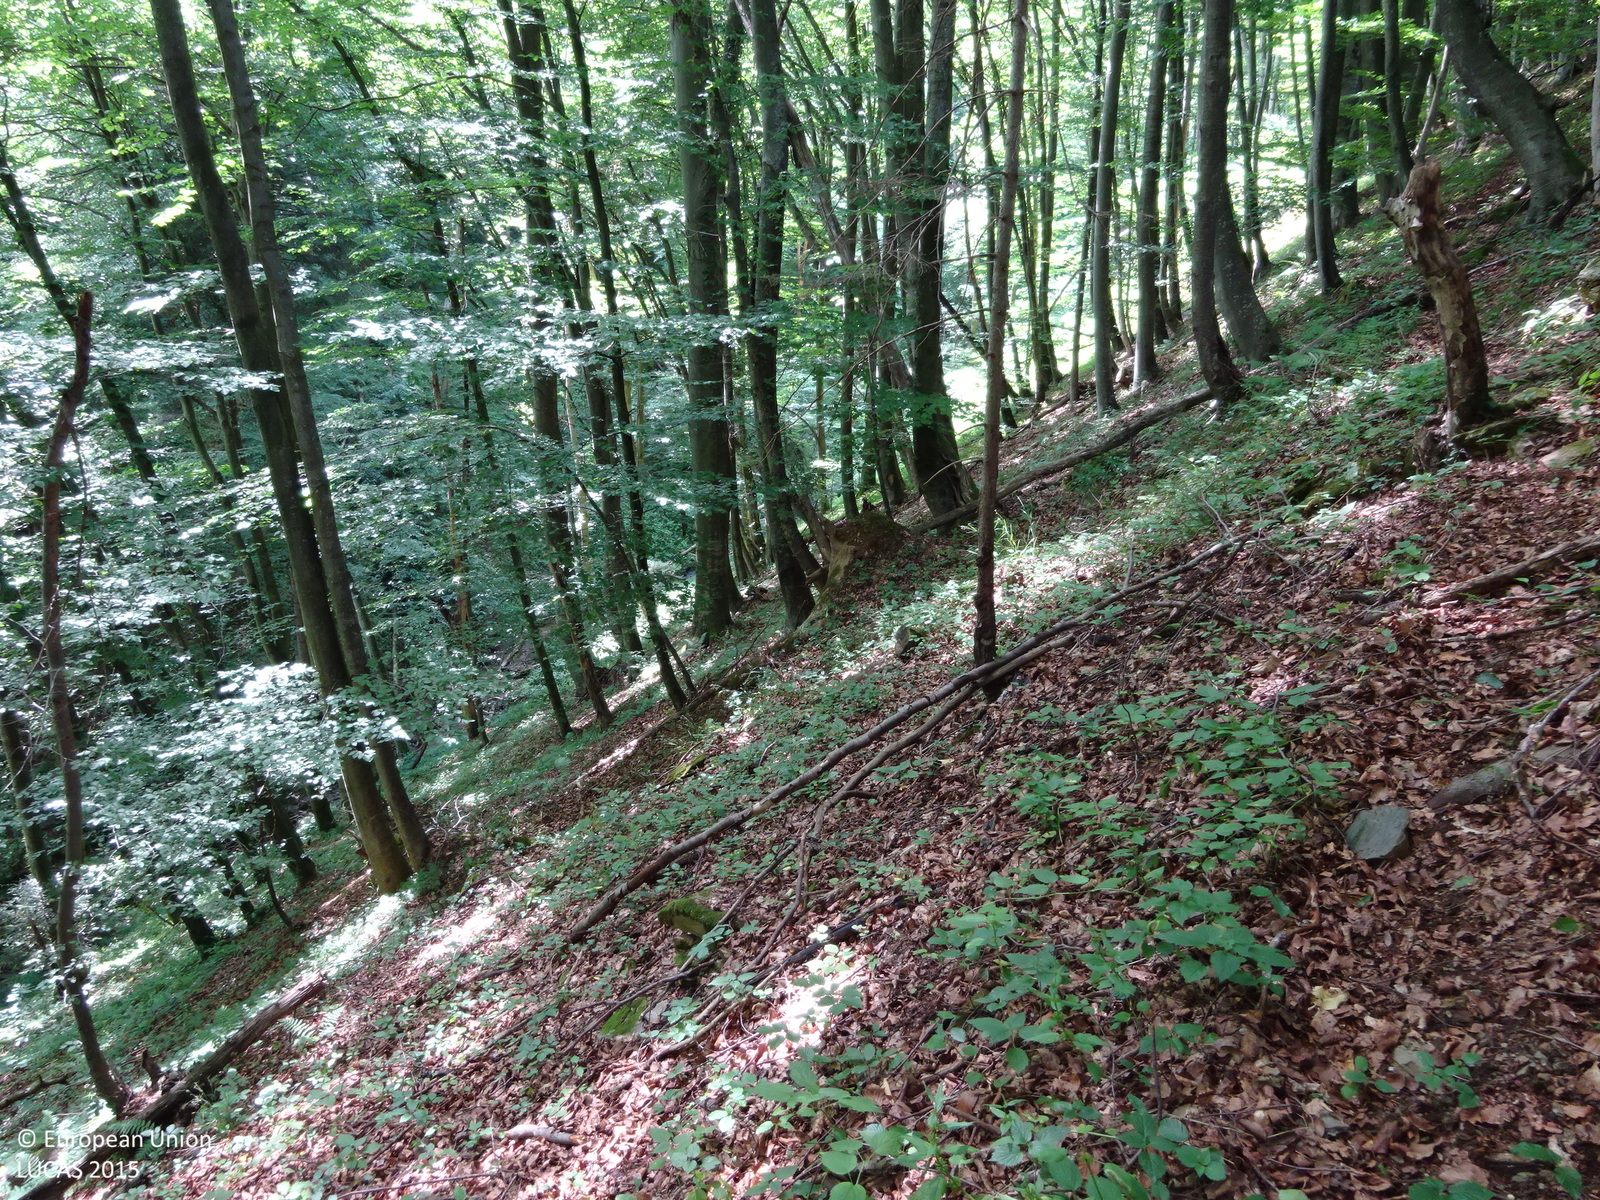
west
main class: Woodland
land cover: Broadleaved woodland
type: mountainous beech forest
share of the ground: > 75 %
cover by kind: broadleaved forest trees 100 %
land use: Forestry
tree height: > 5 m
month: July
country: AT
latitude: 46.7906
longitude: 15.4358
